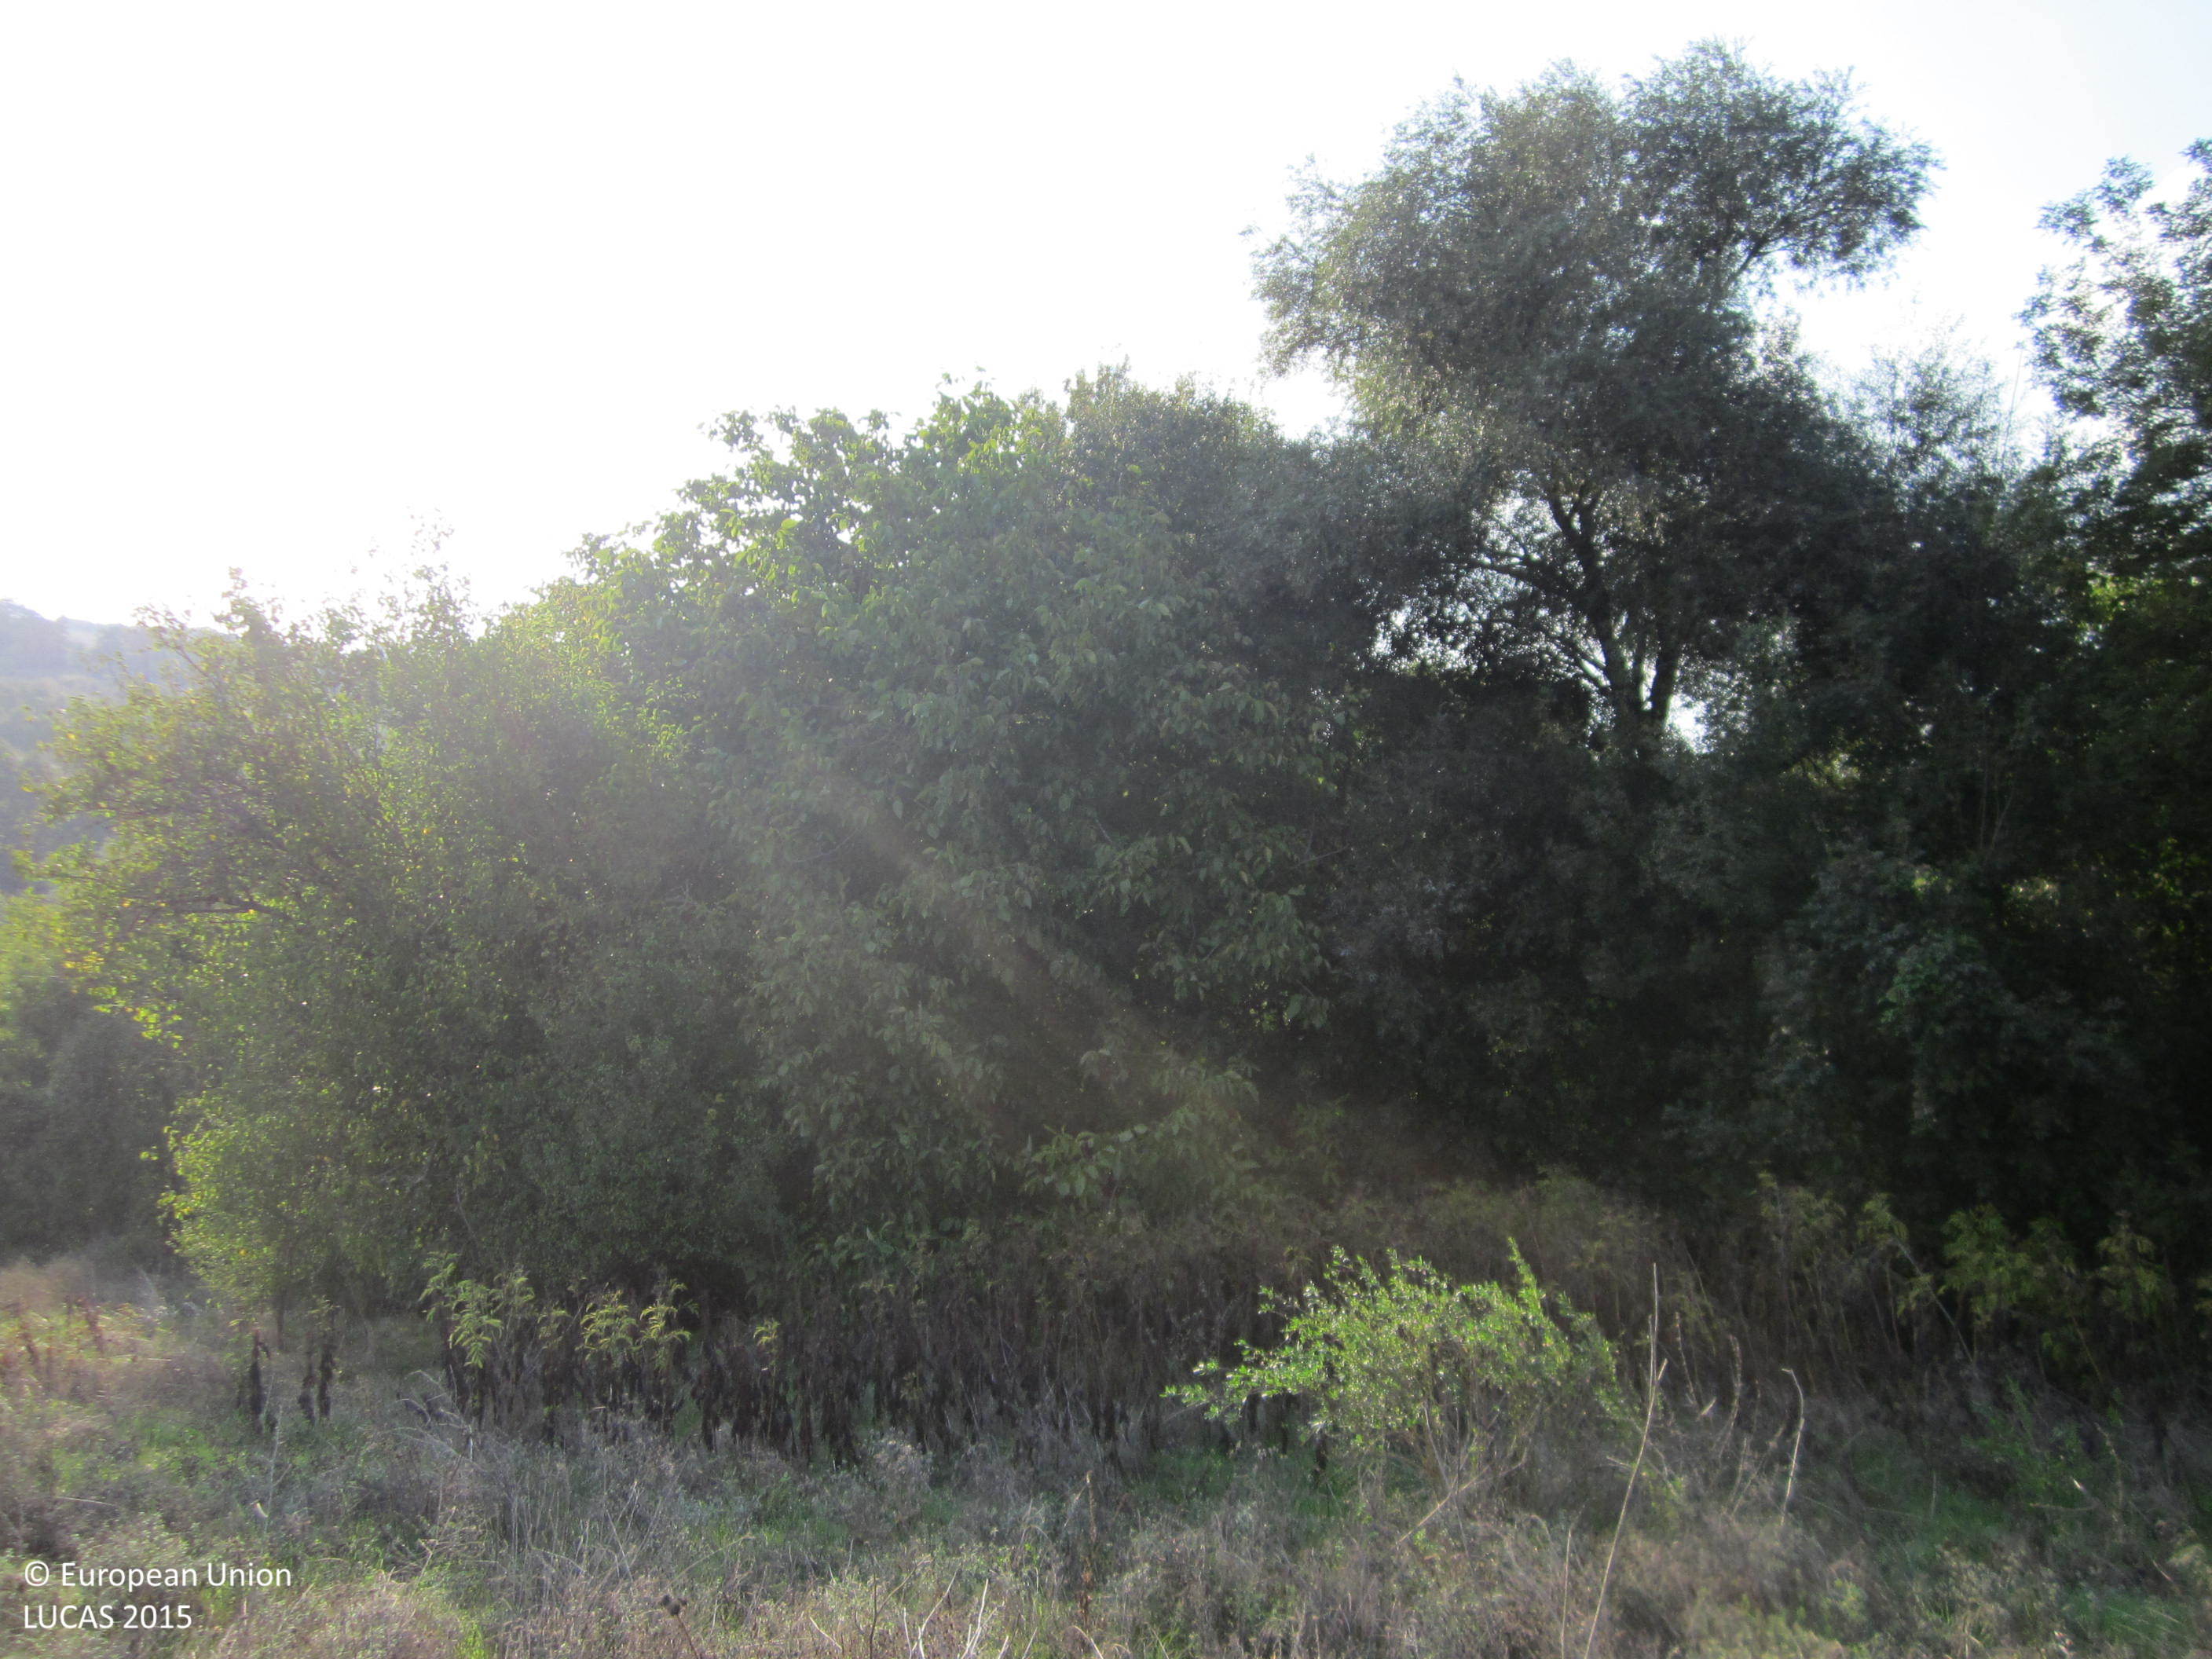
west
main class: Grassland
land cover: Grassland without tree/shrub cover
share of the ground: > 75 %
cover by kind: herbaceous plants 95 %, shrubs 5 %
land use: Agriculture (excluding fallow land and kitchen gardens)
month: October
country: BG
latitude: 42.2996
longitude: 26.9490
